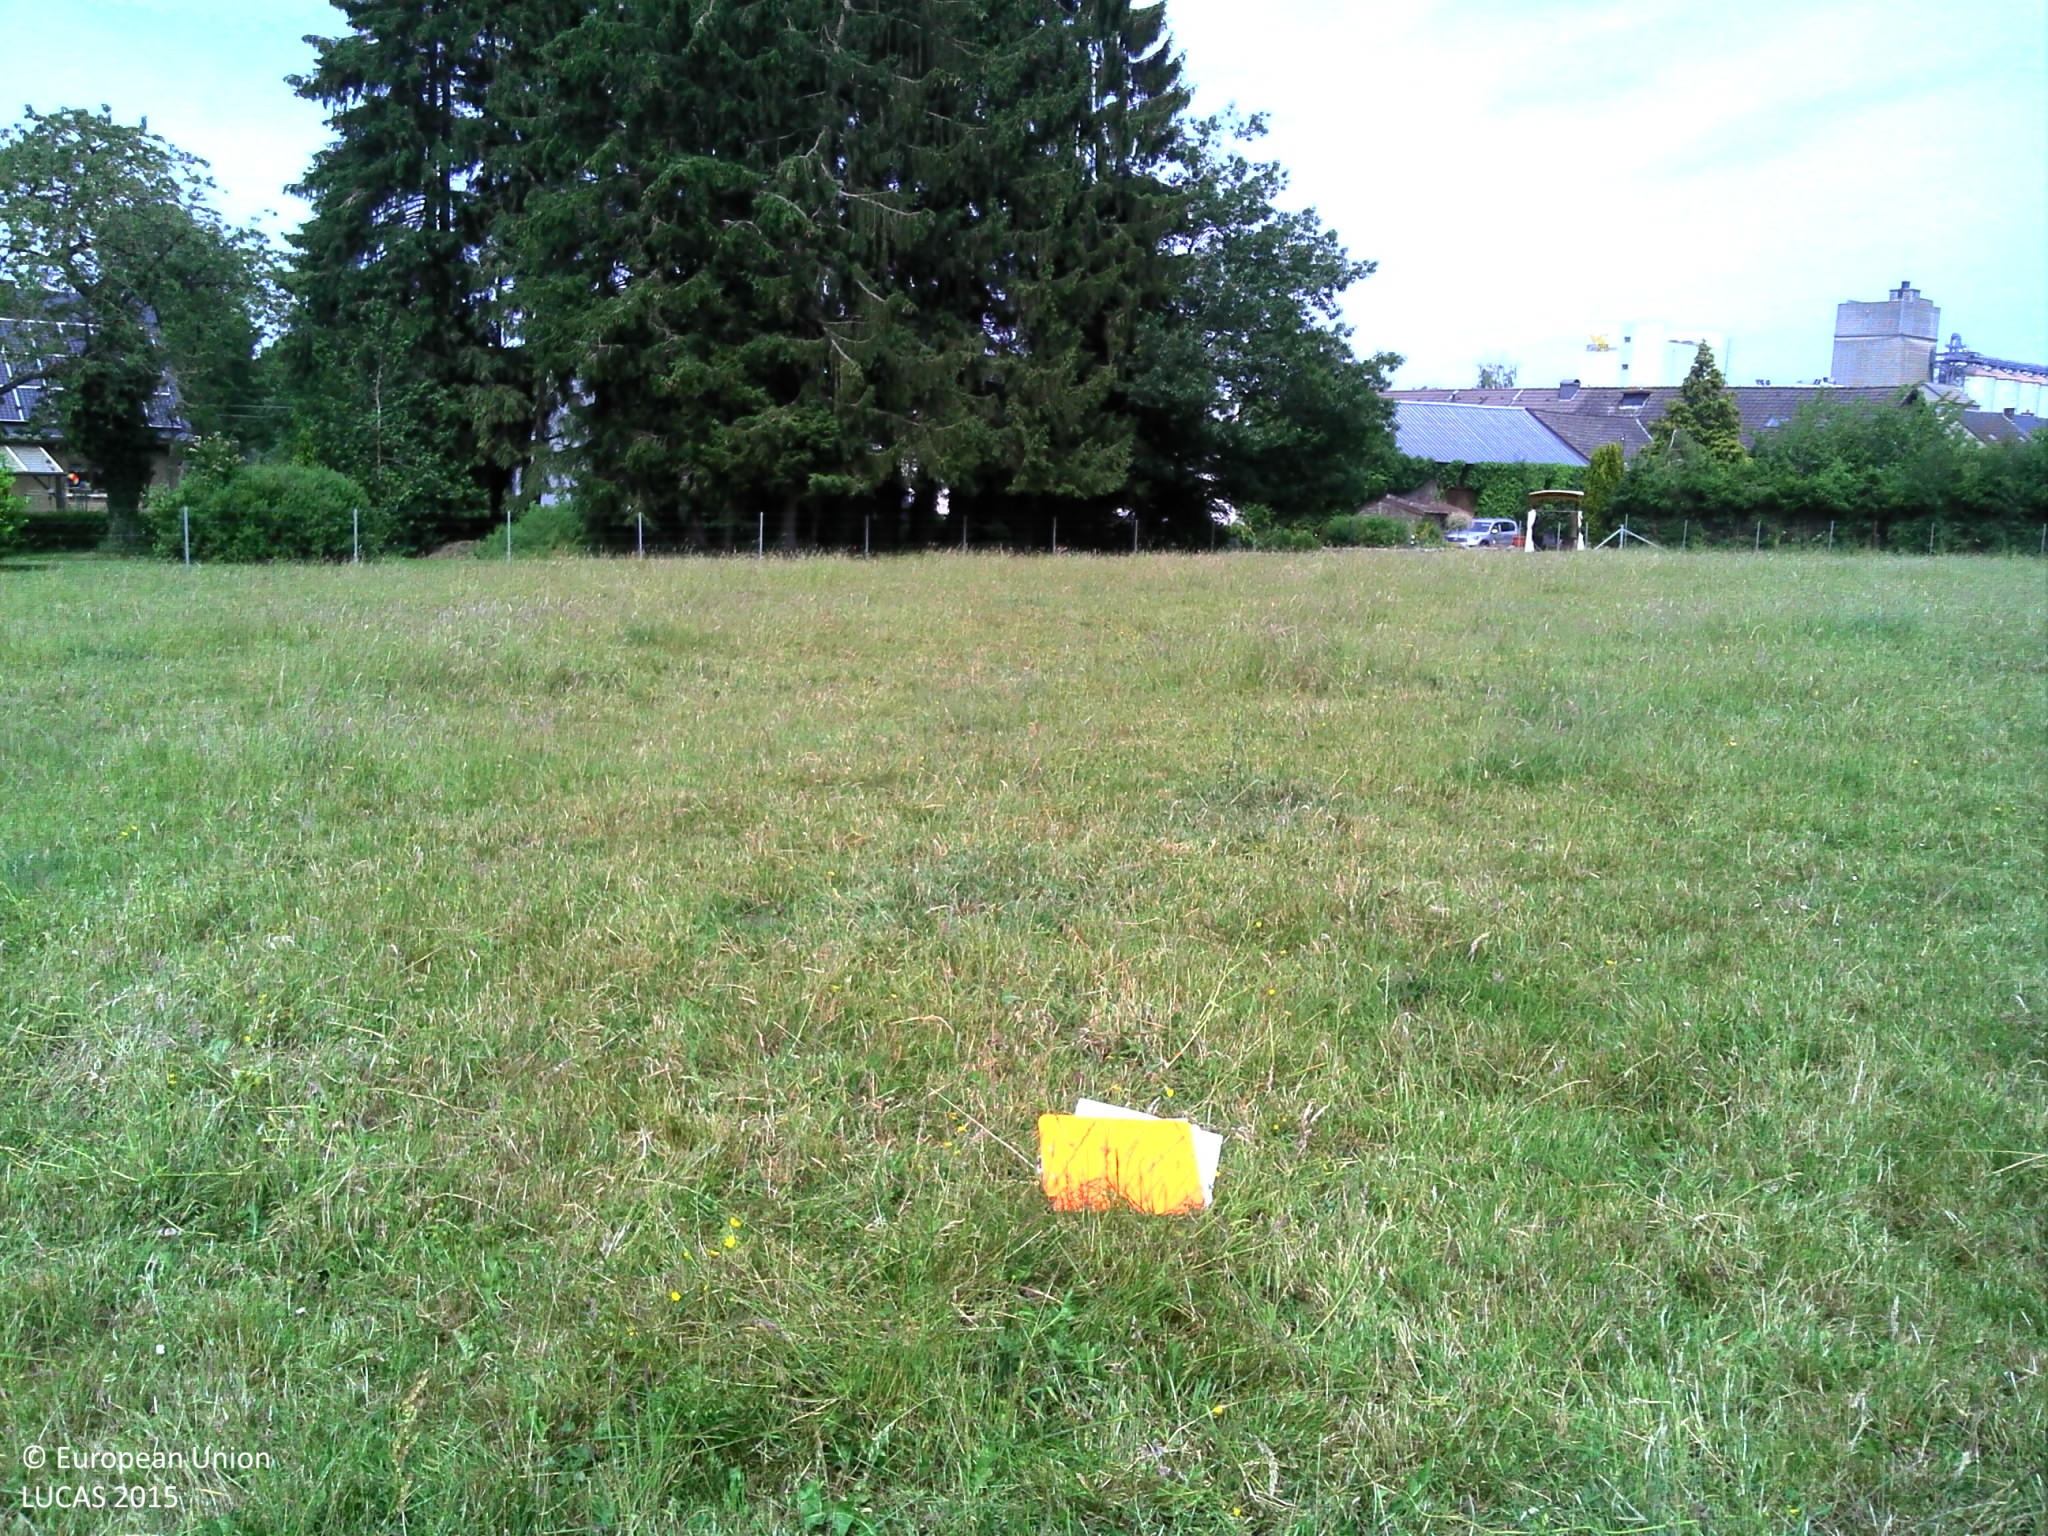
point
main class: Grassland
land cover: Grassland without tree/shrub cover
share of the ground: > 75 %
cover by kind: herbaceous plants 100 %
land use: Agriculture (excluding fallow land and kitchen gardens)
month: June
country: LU
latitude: 49.6429
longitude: 5.9138
